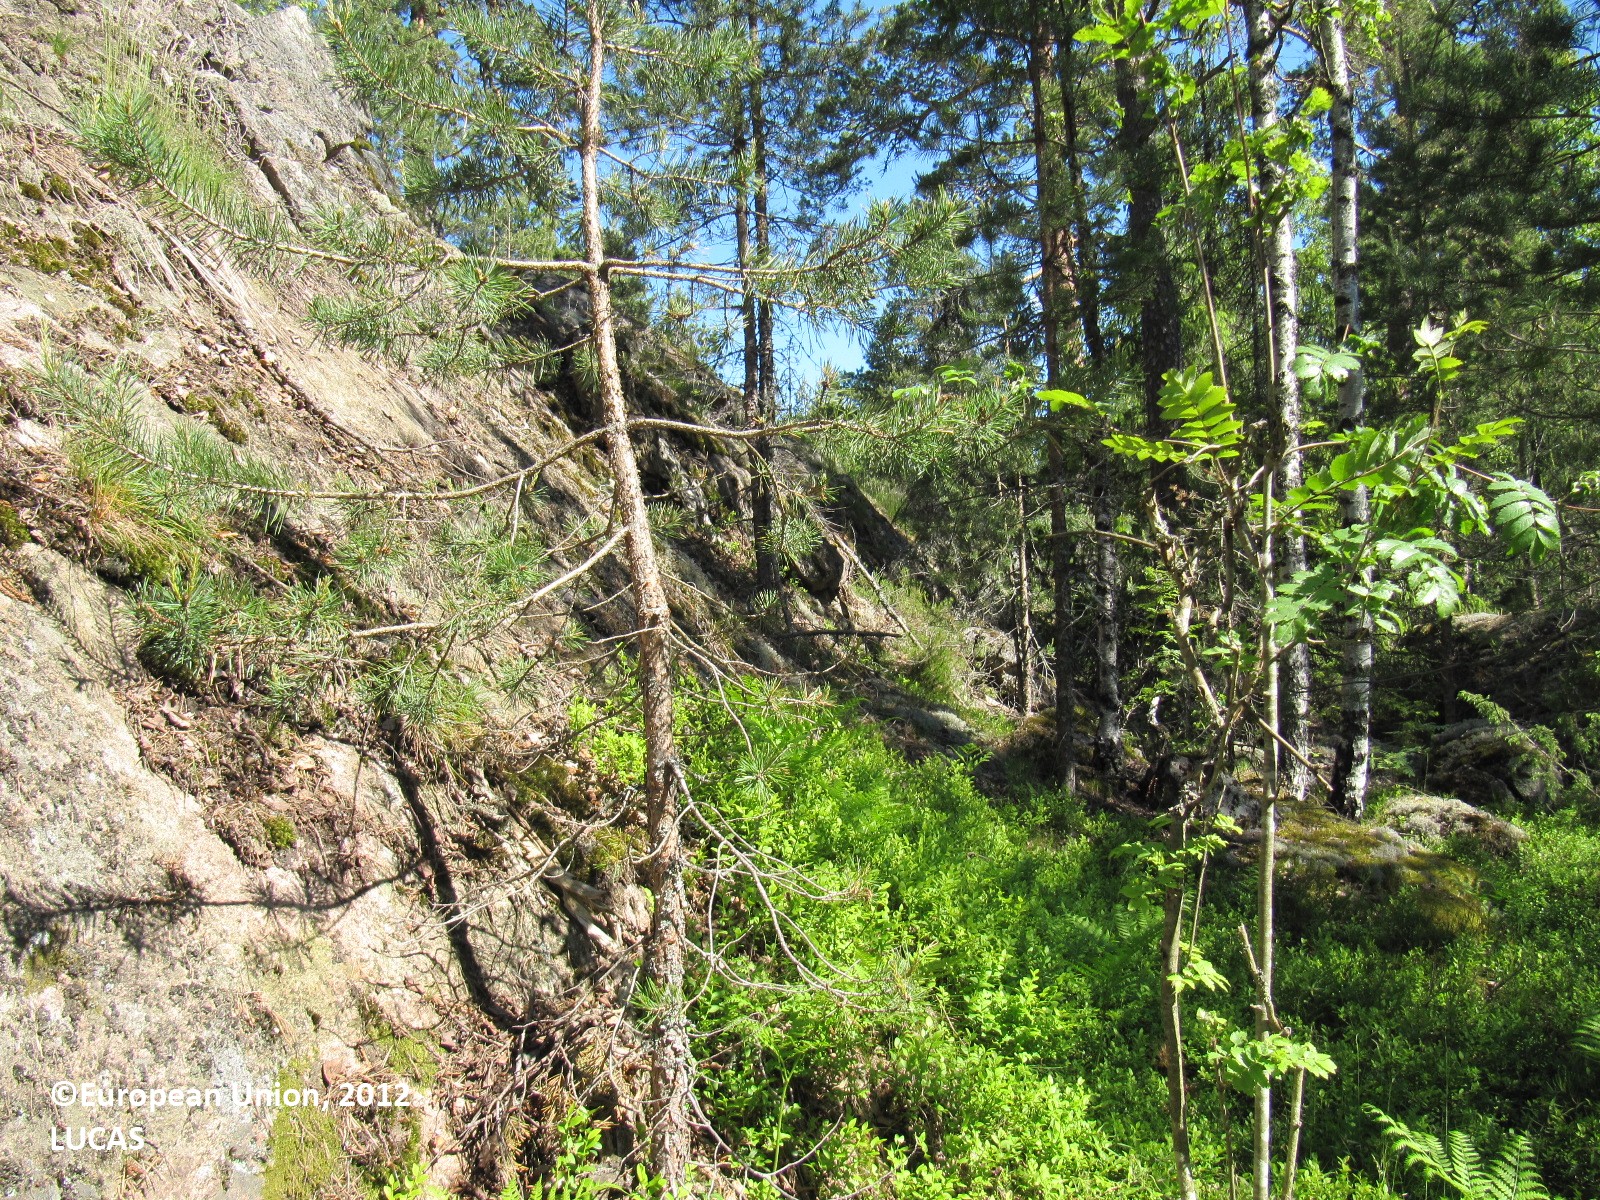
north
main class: Woodland
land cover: Pine dominated mixed woodland
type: boreal forest
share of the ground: 25 - 50 %
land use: Forestry
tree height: > 5 m
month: June
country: FI
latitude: 60.1495
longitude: 24.2424
